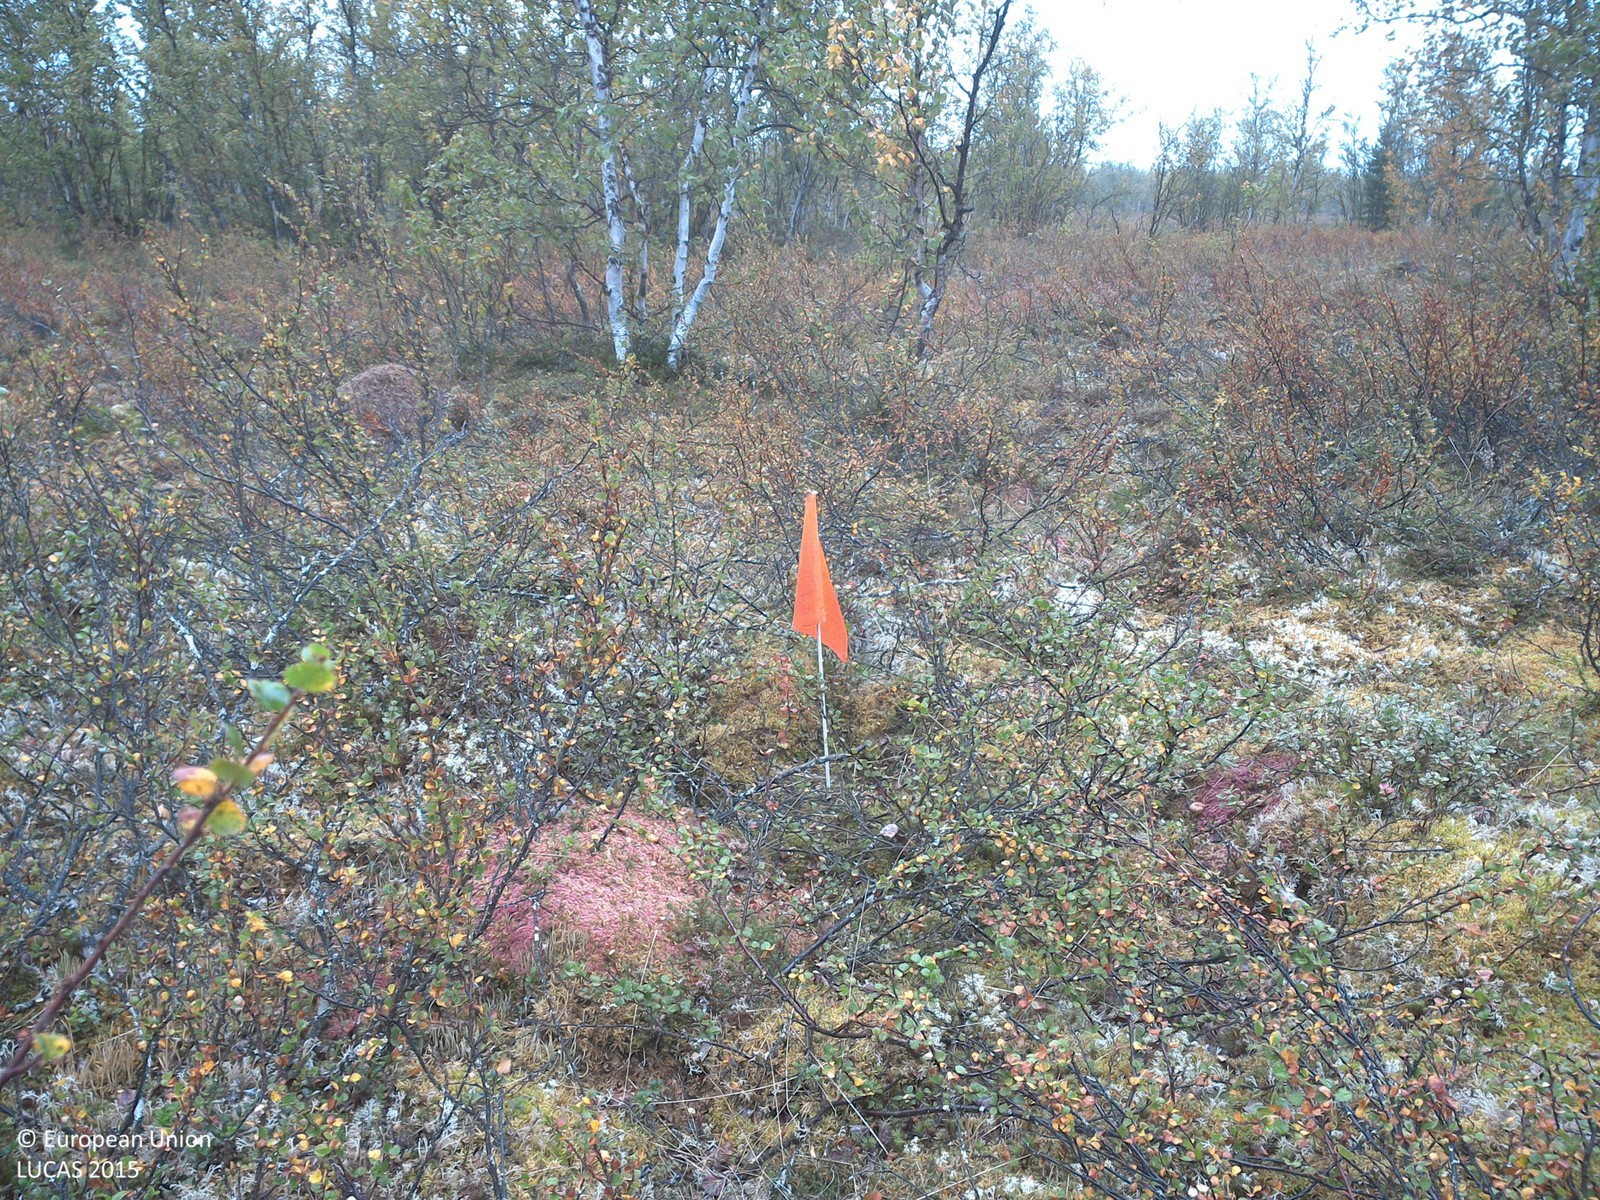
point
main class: Woodland
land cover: Broadleaved woodland
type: boreal forest
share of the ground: 10 - 25 %
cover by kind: shrubs 55 %, lichens and mosses 25 %, broadleaved forest trees 20 %
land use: Amenities, museums, leisure
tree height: > 5 m
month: August
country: SE
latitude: 68.1913
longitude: 21.8335
